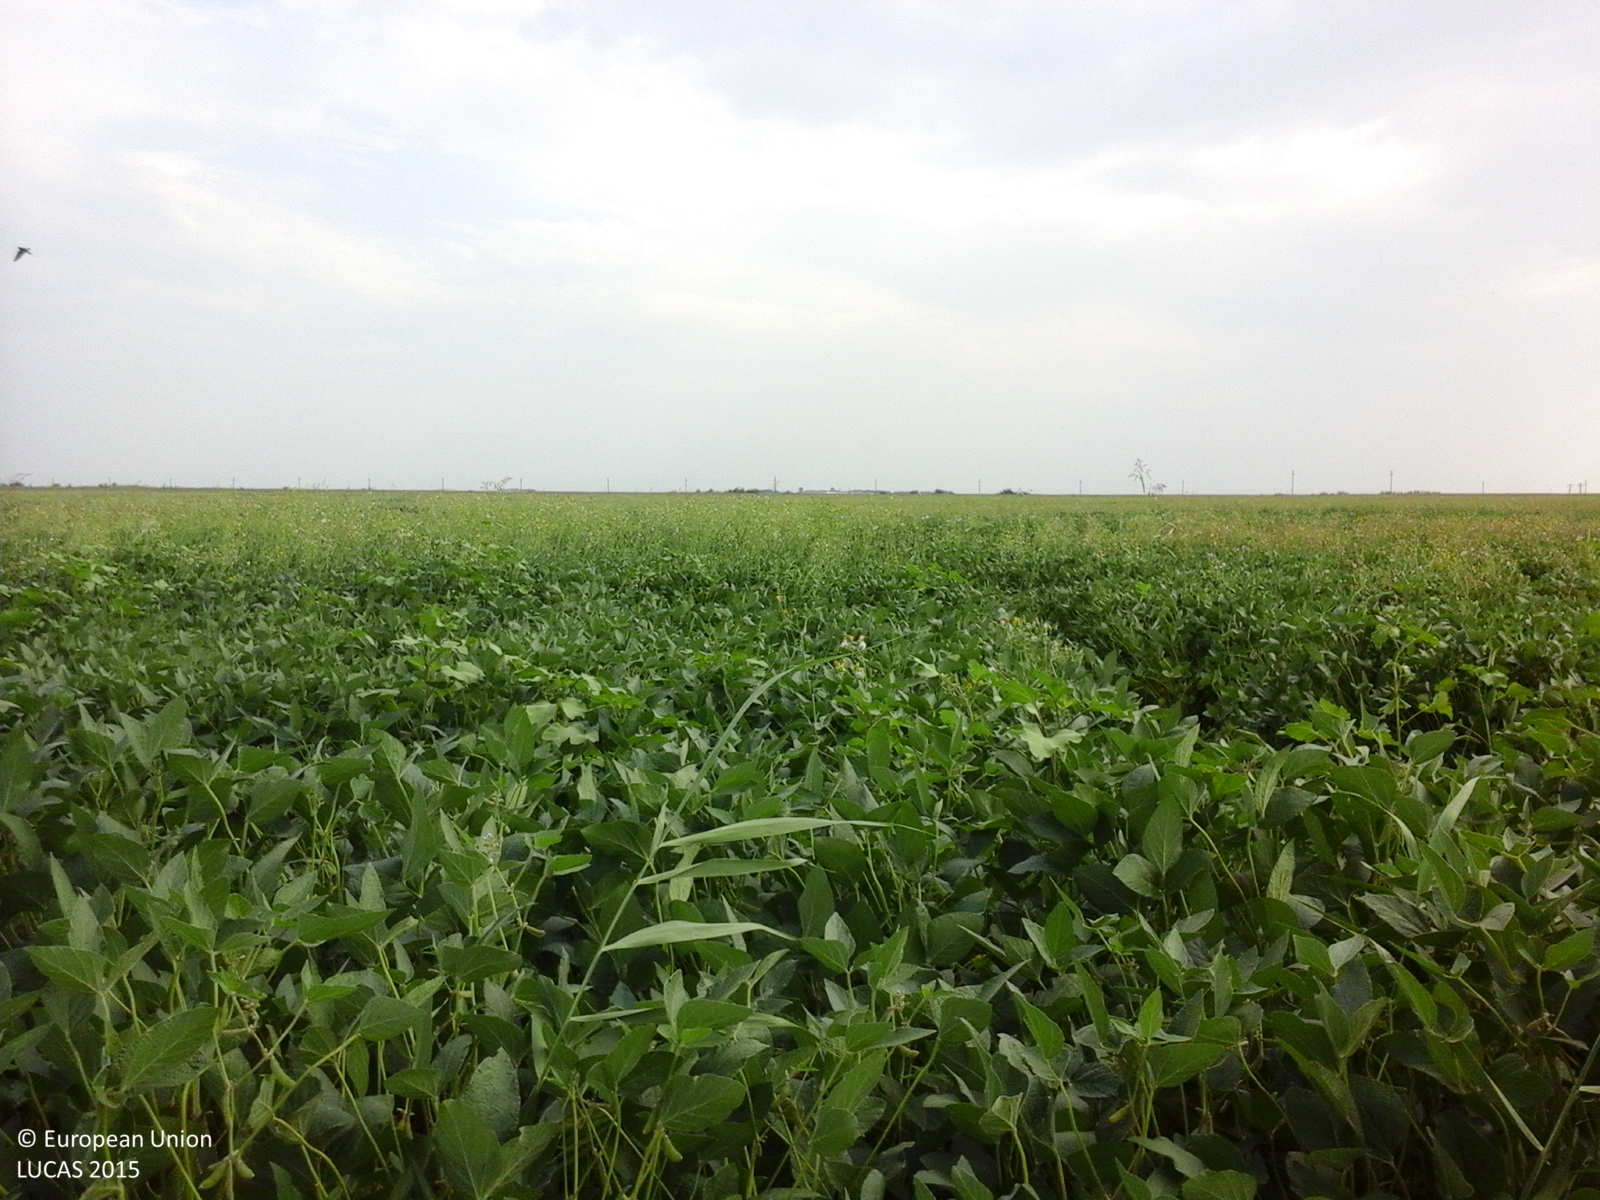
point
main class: Cropland
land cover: Soya
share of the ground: > 75 %
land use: Agriculture (excluding fallow land and kitchen gardens)
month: August
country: RO
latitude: 45.1202
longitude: 27.6857
